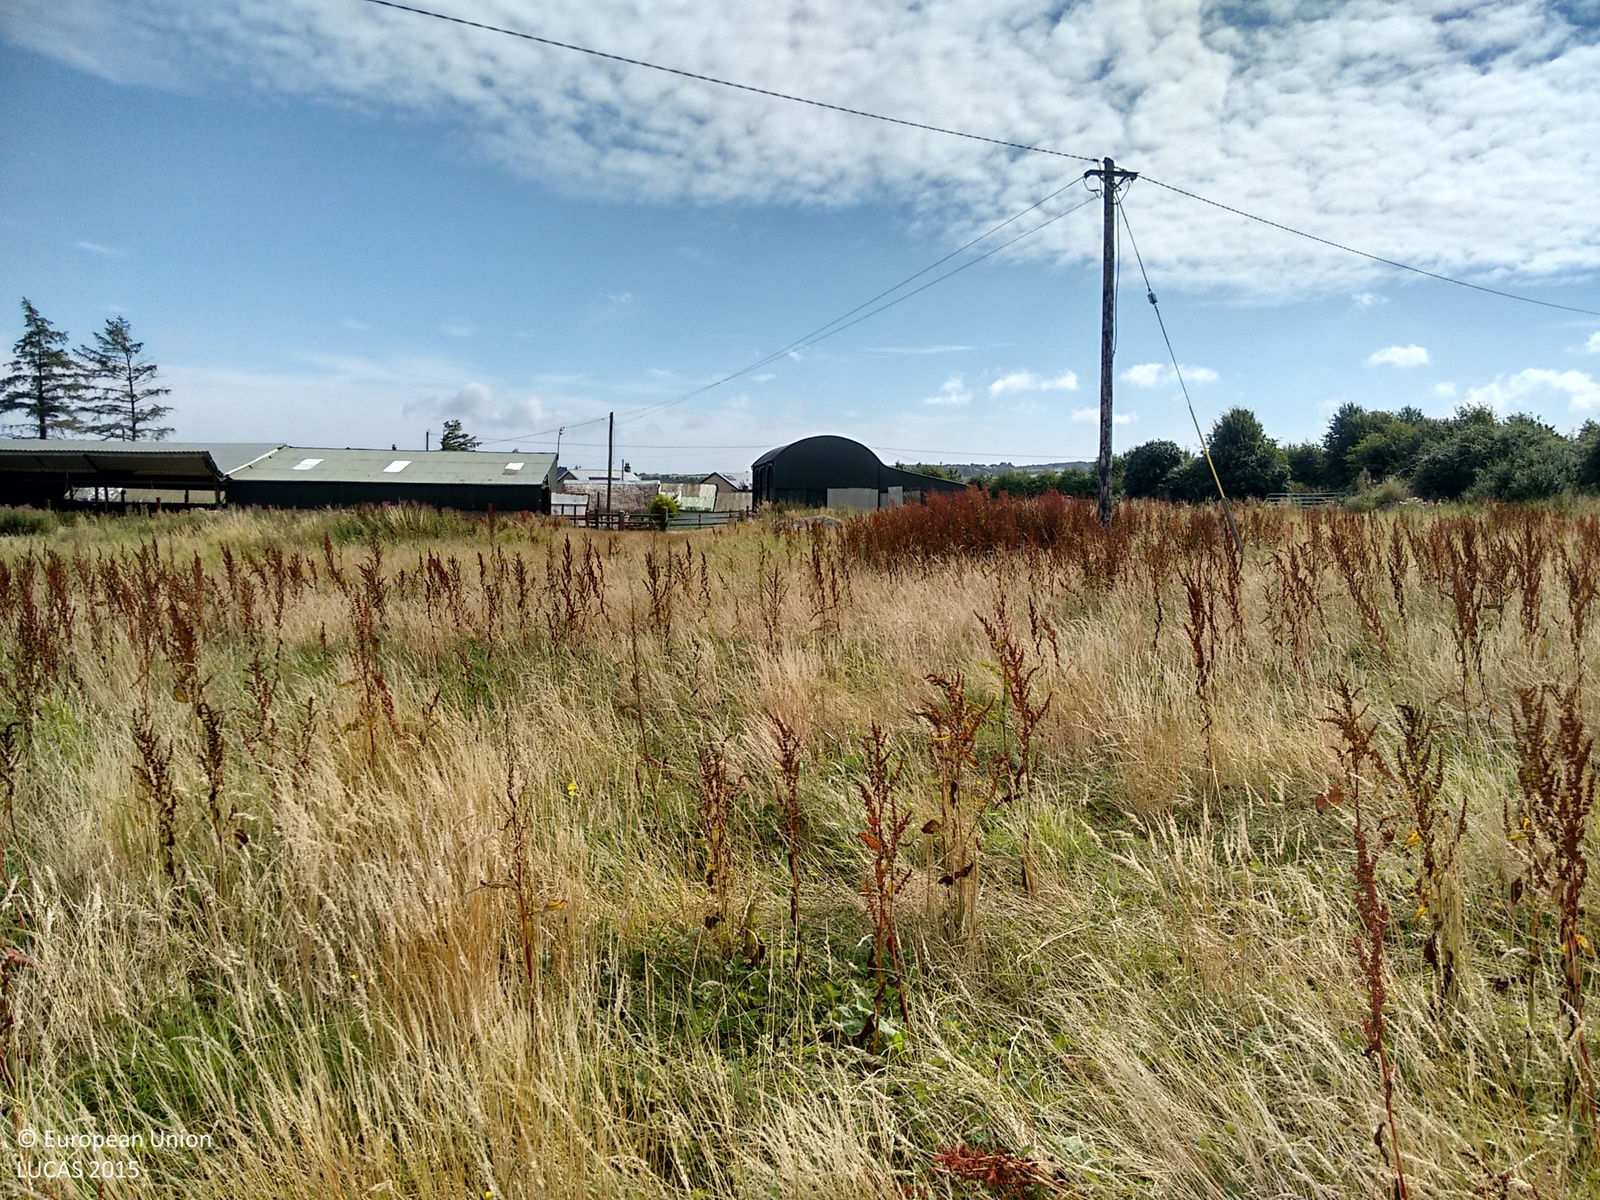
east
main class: Grassland
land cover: Spontaneously vegetated surfaces
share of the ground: > 75 %
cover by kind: herbaceous plants 95 %, shrubs 5 %
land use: Fallow land
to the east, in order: Spontaneously vegetated surfaces; Electric lines; Spontaneously vegetated surfaces; Electric lines; Spontaneously vegetated surfaces; Artificial constructions in urban areas
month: August
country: IE
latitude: 53.8133
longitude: -6.4201
